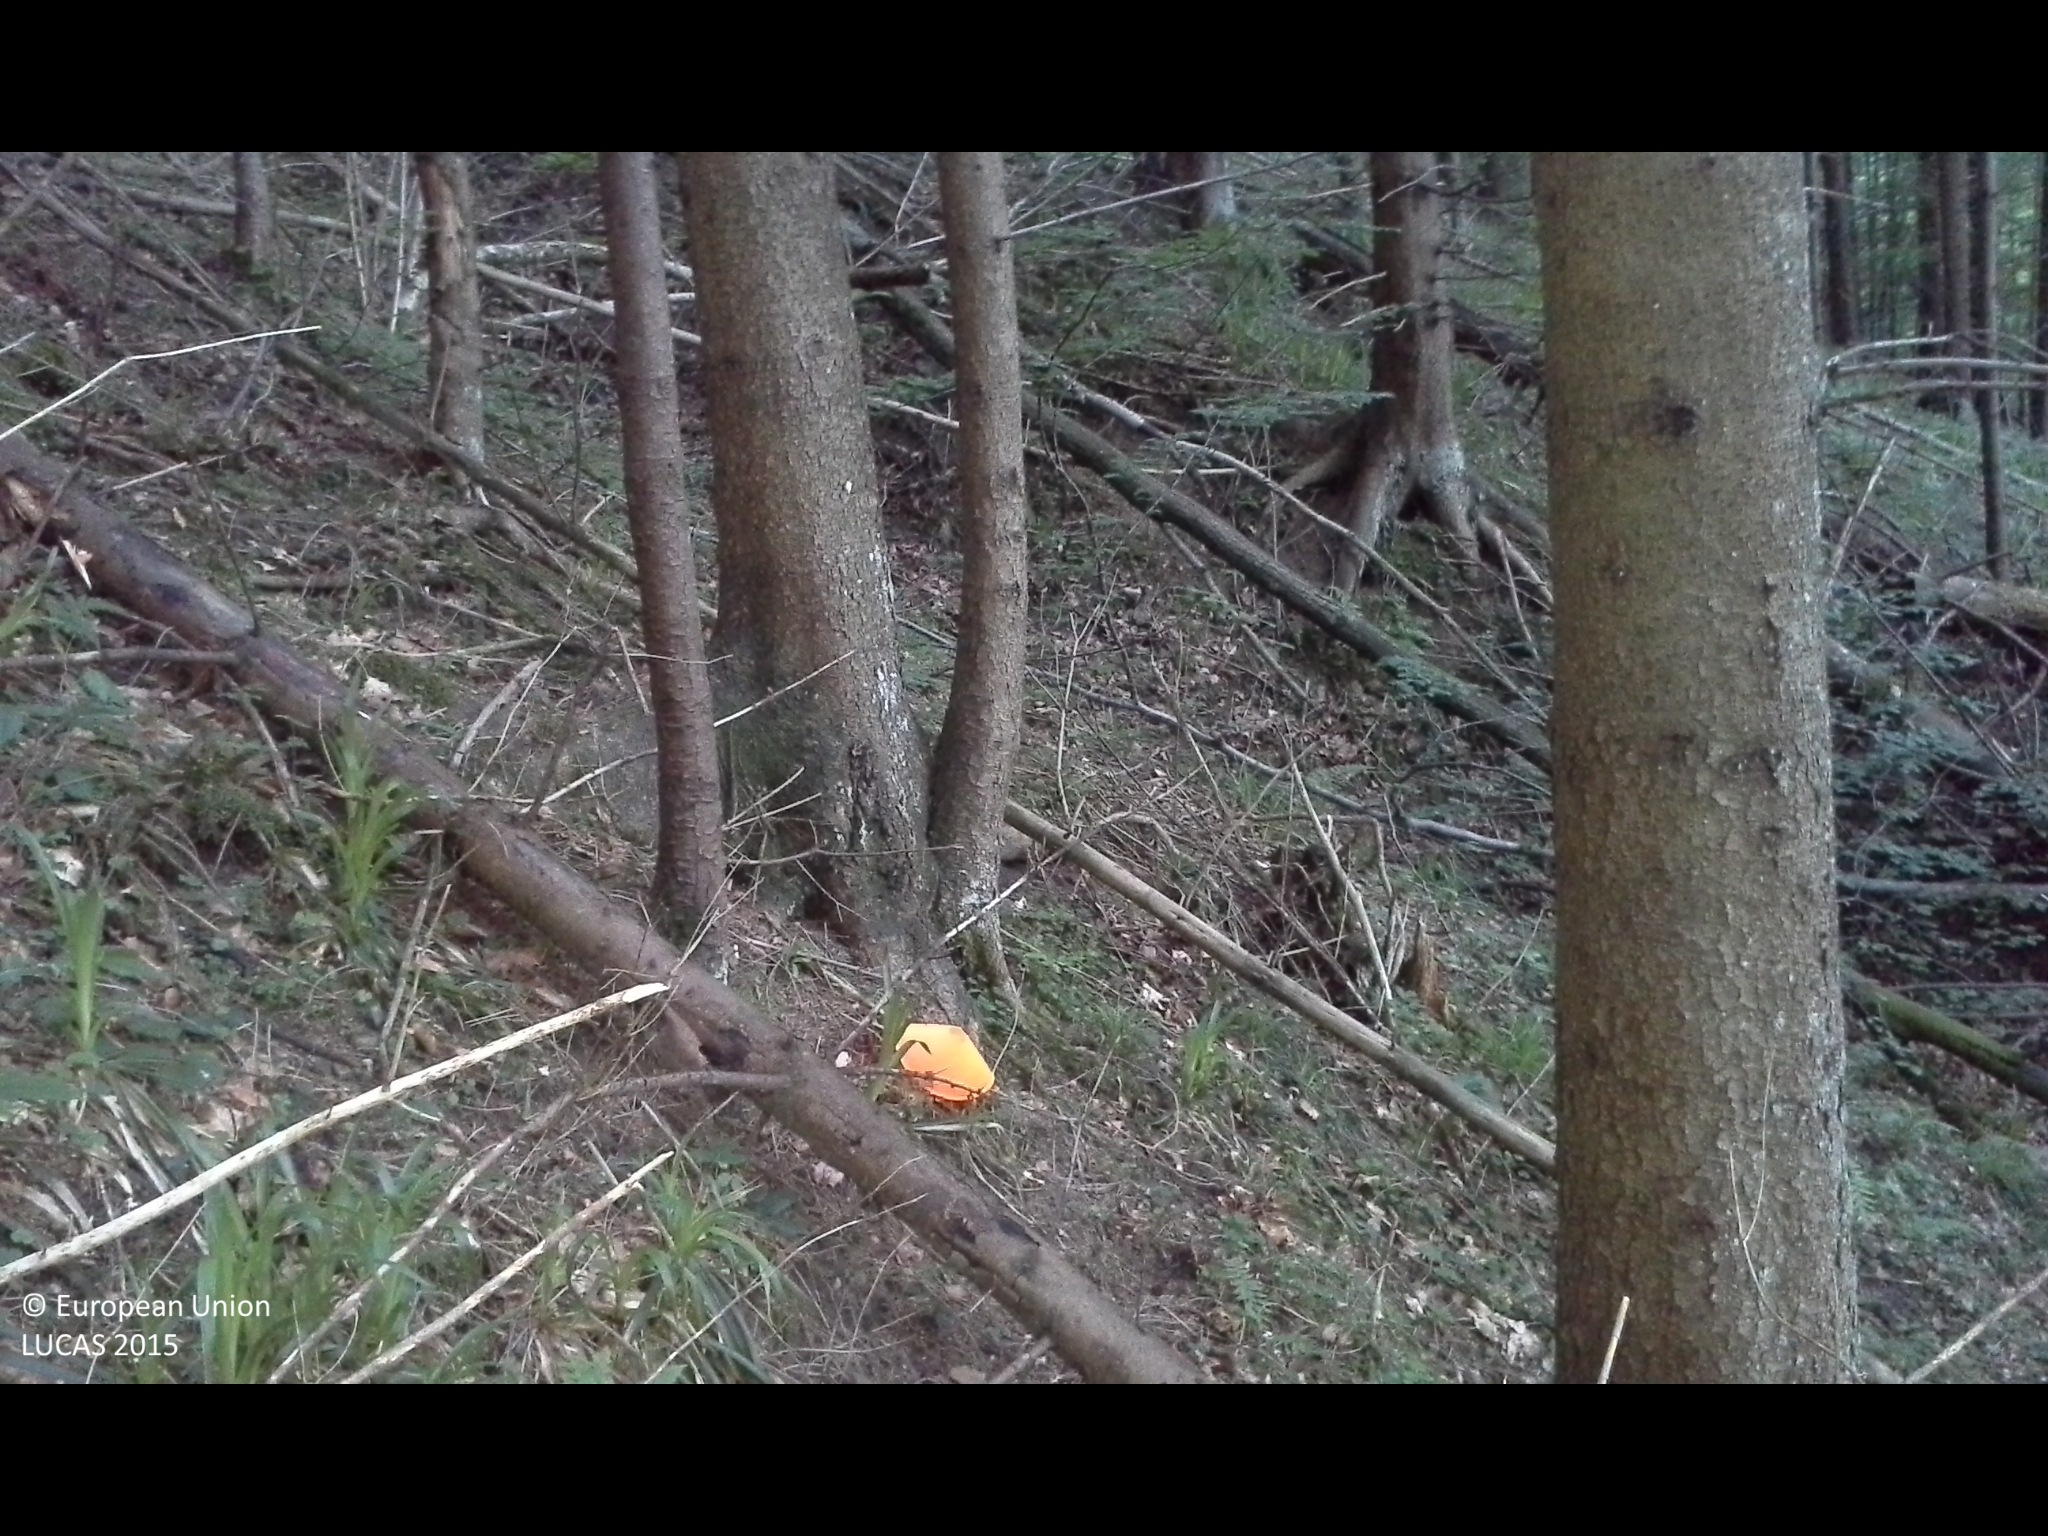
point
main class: Woodland
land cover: Spruce dominated mixed woodland
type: hemiboreal forest and nemoral coniferous forest and mixed broadleaved-coniferous forest
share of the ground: > 75 %
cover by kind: coniferous forest trees 75 %, broadleaved forest trees 25 %
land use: Forestry
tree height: > 5 m
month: May
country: AT
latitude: 47.9447
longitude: 14.2169
